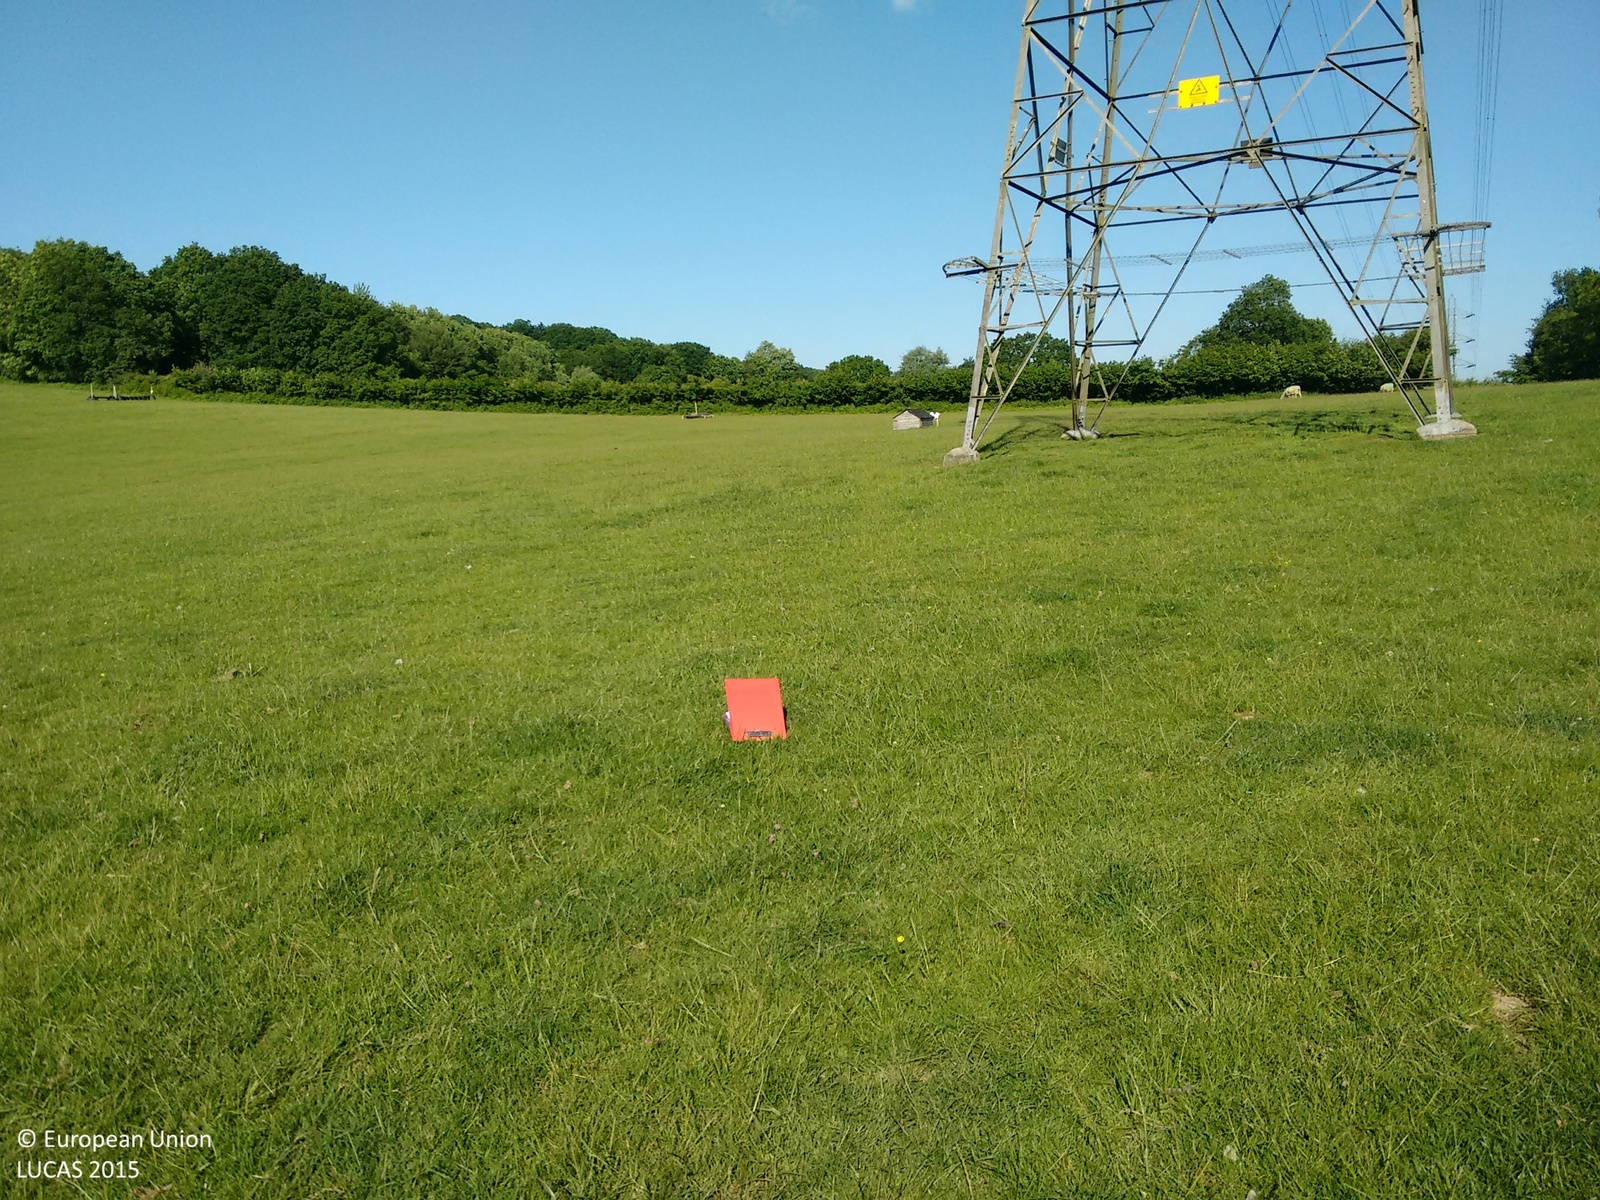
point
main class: Grassland
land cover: Grassland without tree/shrub cover
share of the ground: > 75 %
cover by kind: herbaceous plants 100 %
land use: Agriculture (excluding fallow land and kitchen gardens)
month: June
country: GB
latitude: 50.8974
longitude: 0.5746
